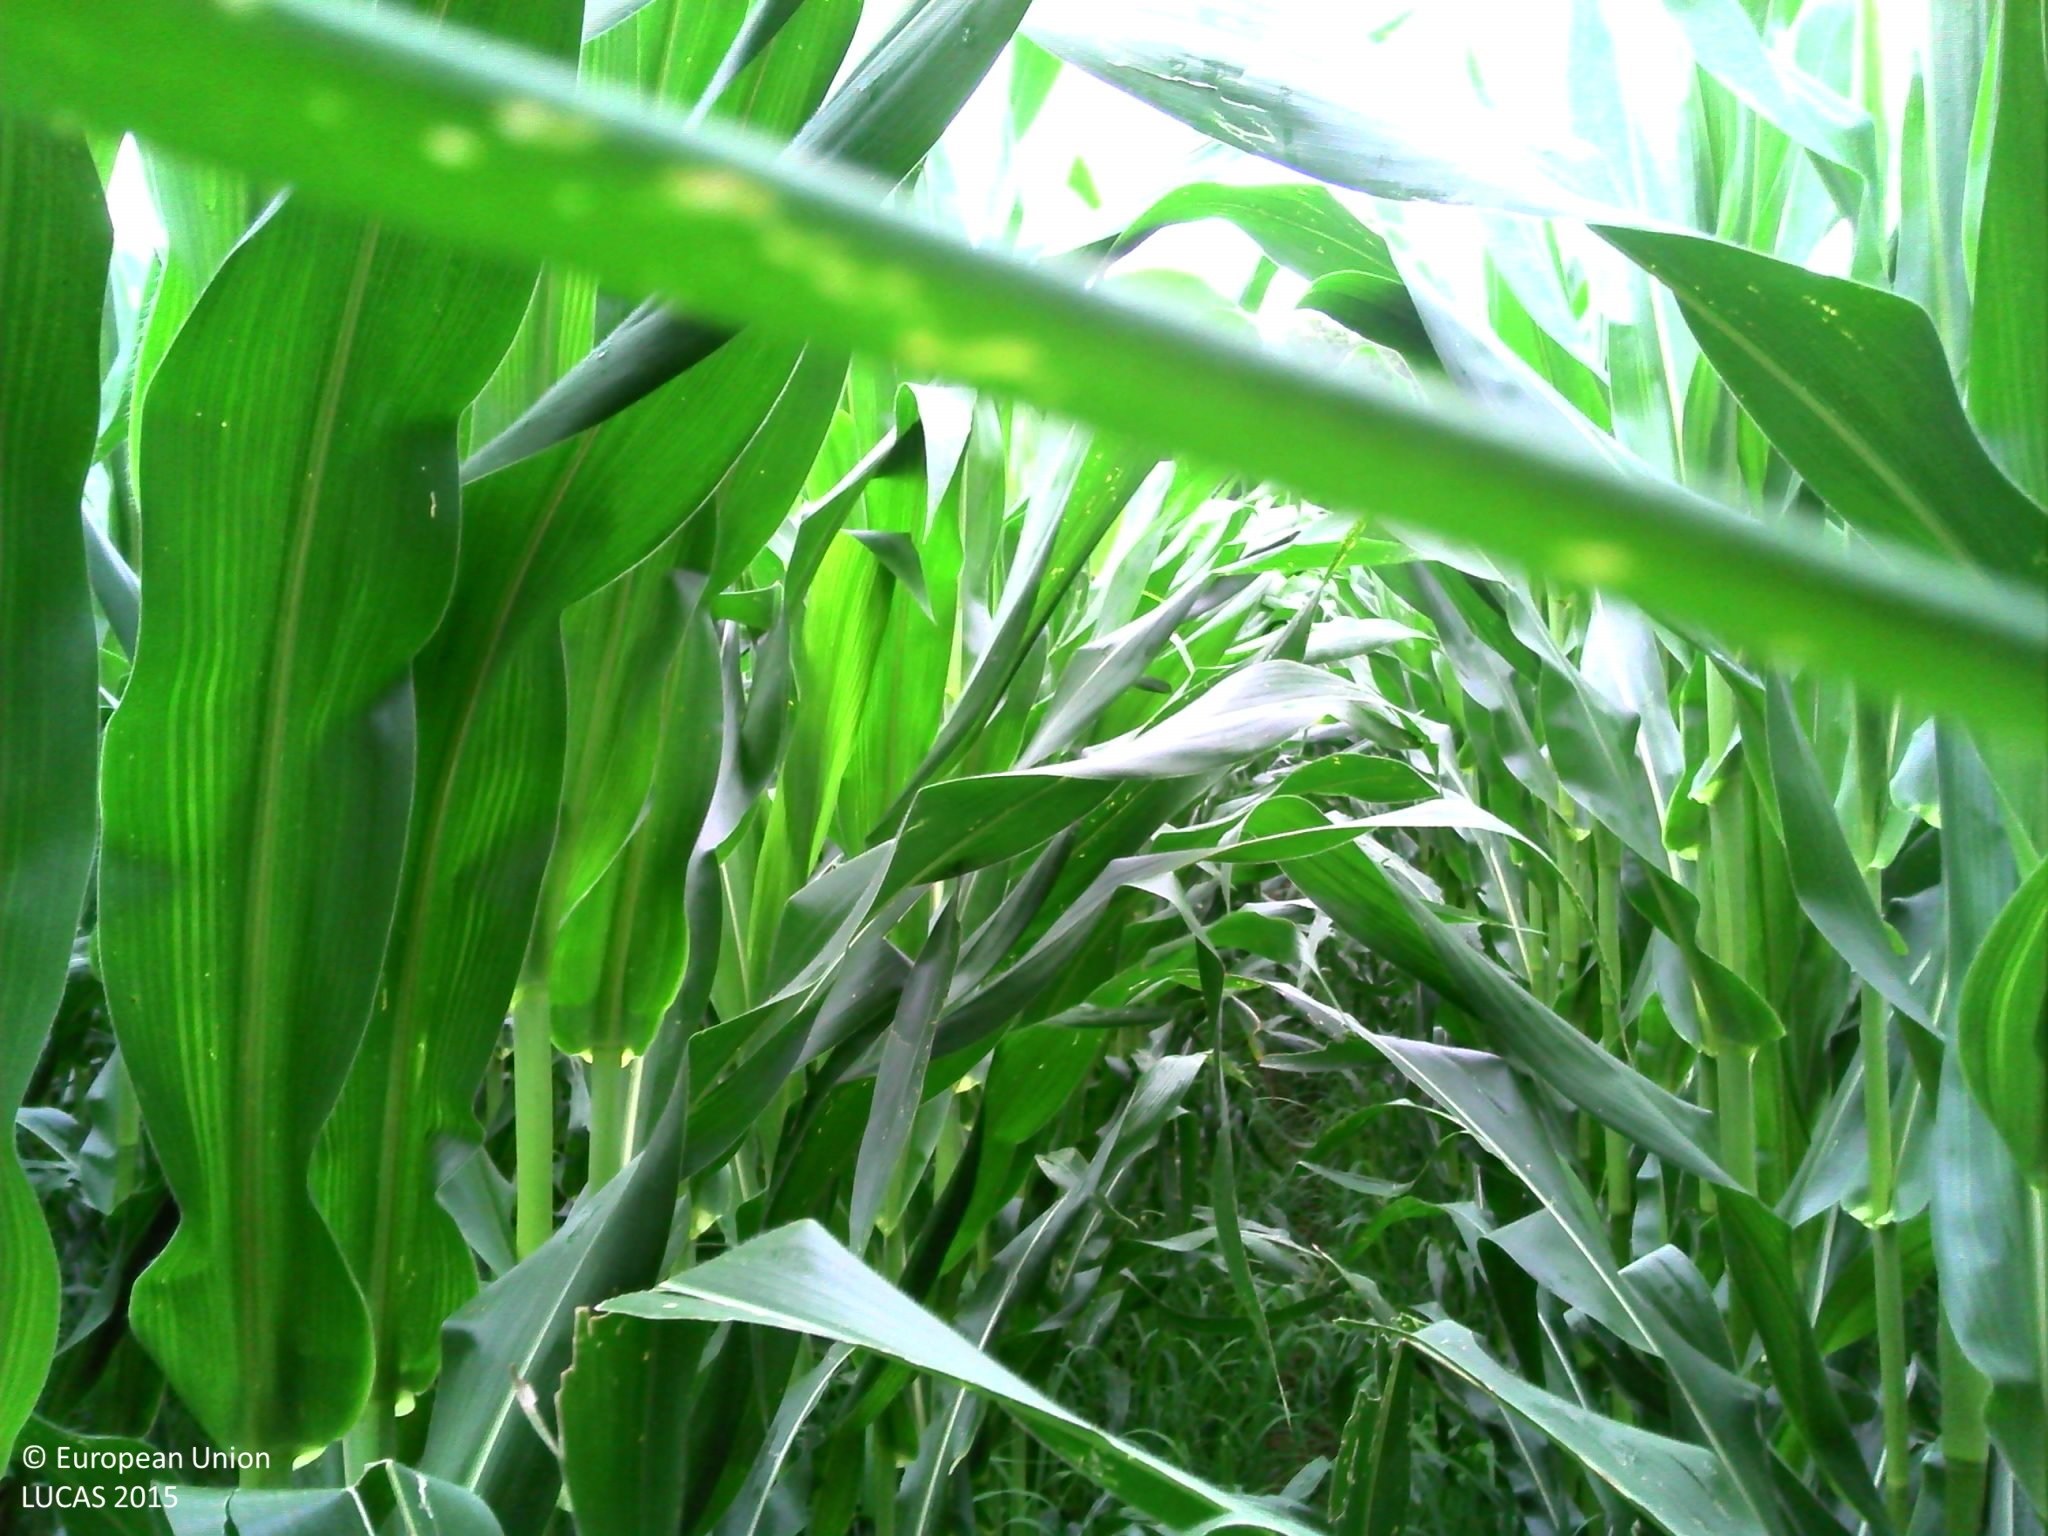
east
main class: Cropland
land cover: Maize
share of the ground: > 75 %
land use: Agriculture (excluding fallow land and kitchen gardens)
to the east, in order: Maize; Fences; Grassland without tree/shrub cover; Fences; Paved roads, cycling and walking lanes; Ditches and canals; Broadleaved woodland; Tracks; Broadleaved woodland; Shrubland with sparse tree cover; Broadleaved woodland
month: August
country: FR
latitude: 43.4307
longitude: -1.2197
